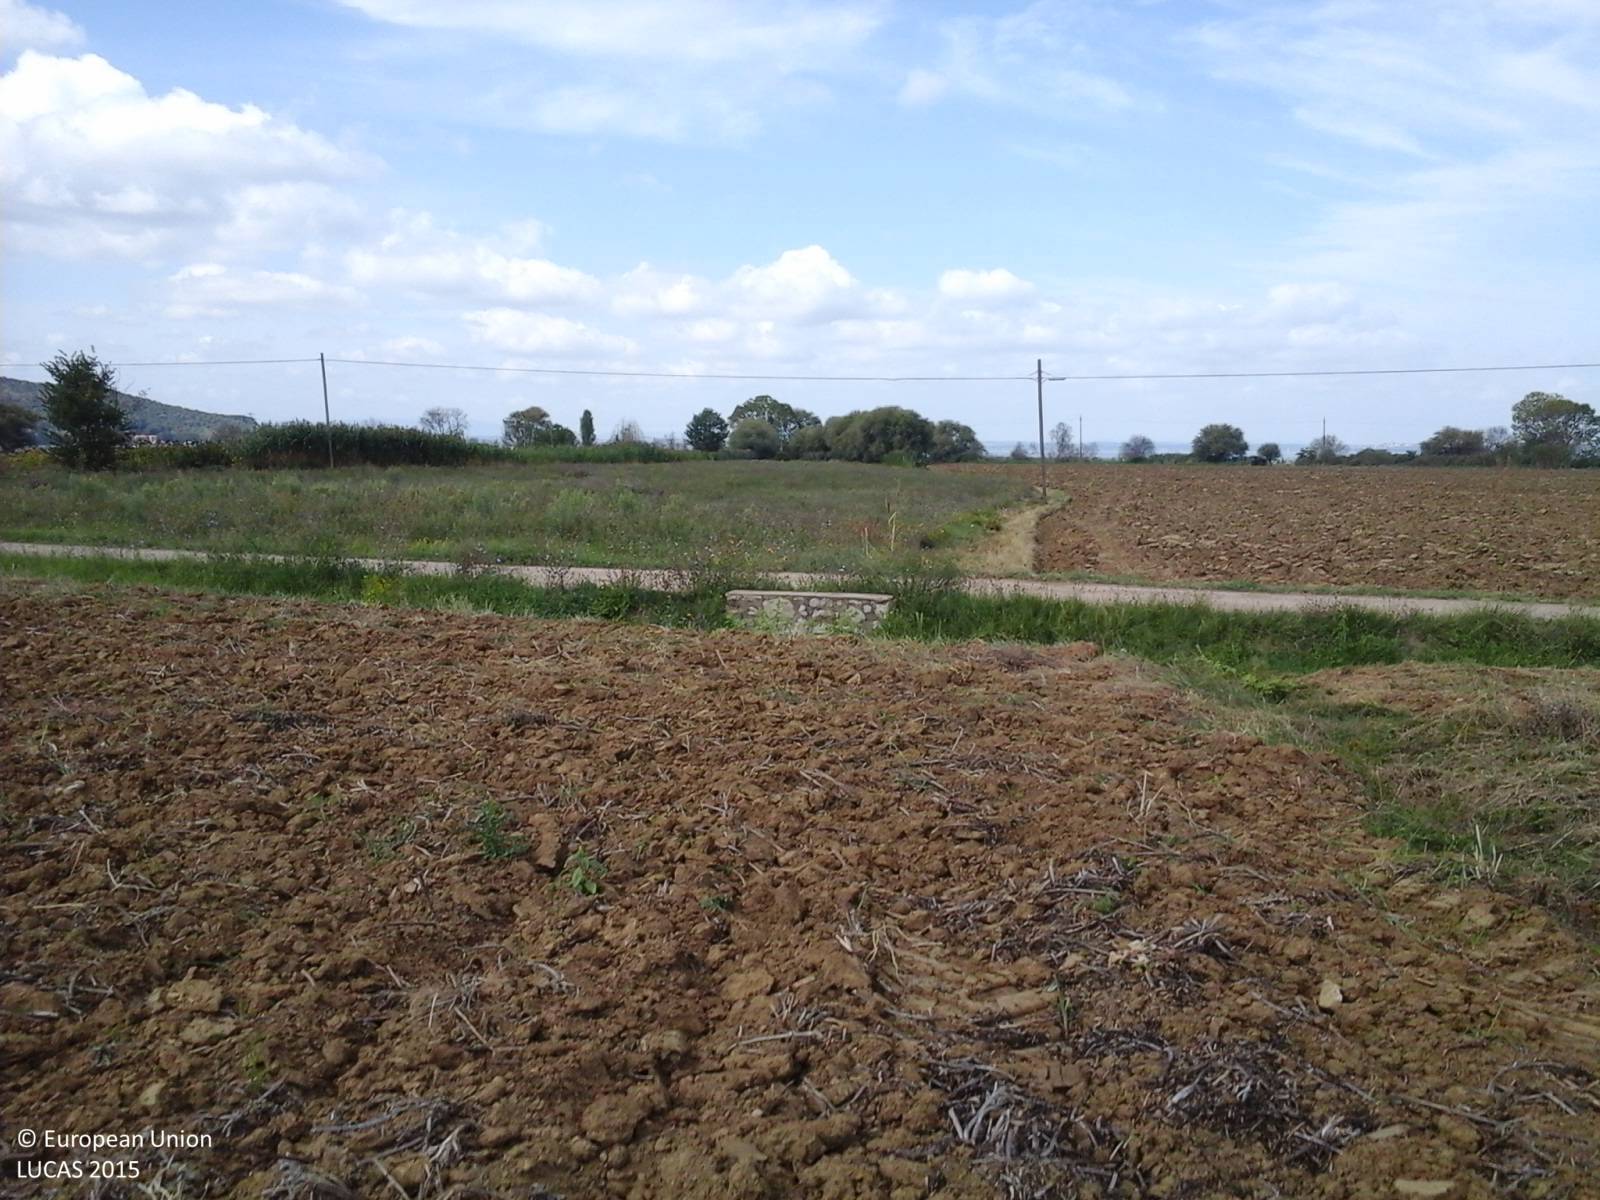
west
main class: Cropland
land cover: Dry pulses
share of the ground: < 10 %
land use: Agriculture (excluding fallow land and kitchen gardens)
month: September
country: IT
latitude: 43.0999
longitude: 12.1929
